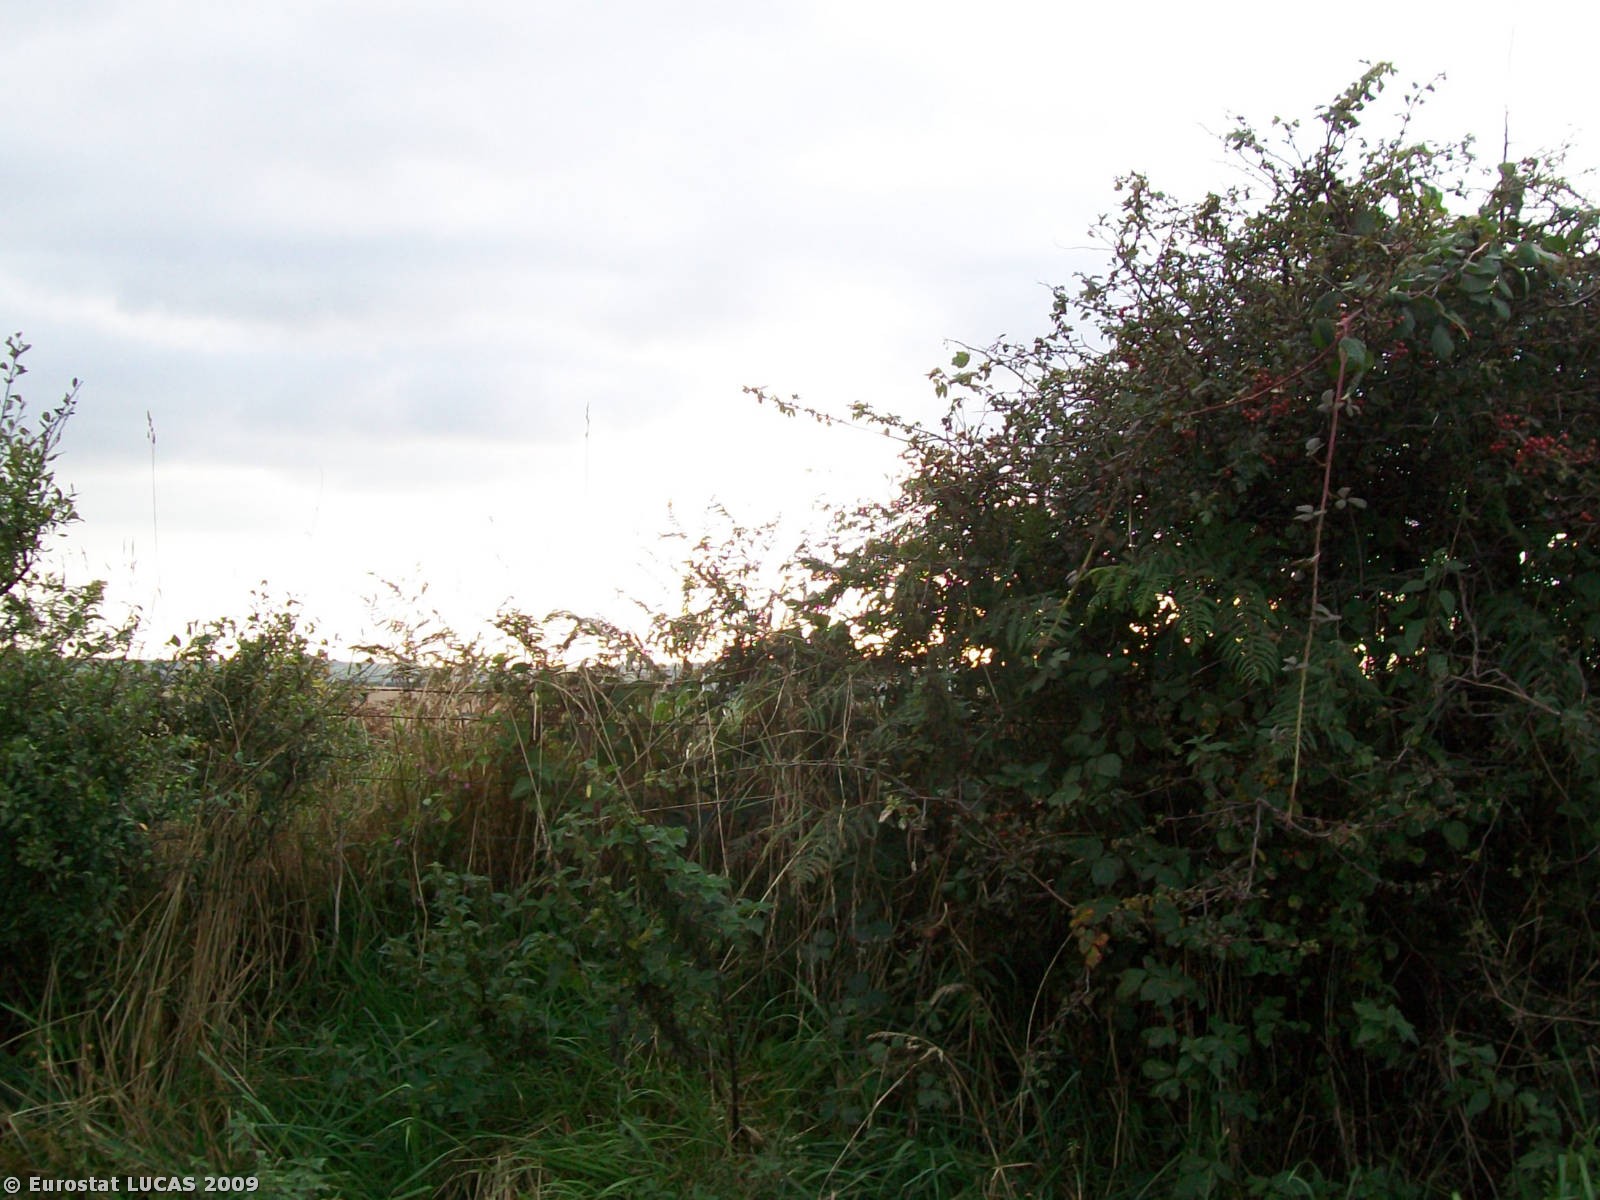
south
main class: Grassland
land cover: Grassland without tree/shrub cover
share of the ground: > 75 %
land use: Agriculture (excluding fallow land and kitchen gardens)
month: September
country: GB
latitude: 51.9613
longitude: -5.0351
